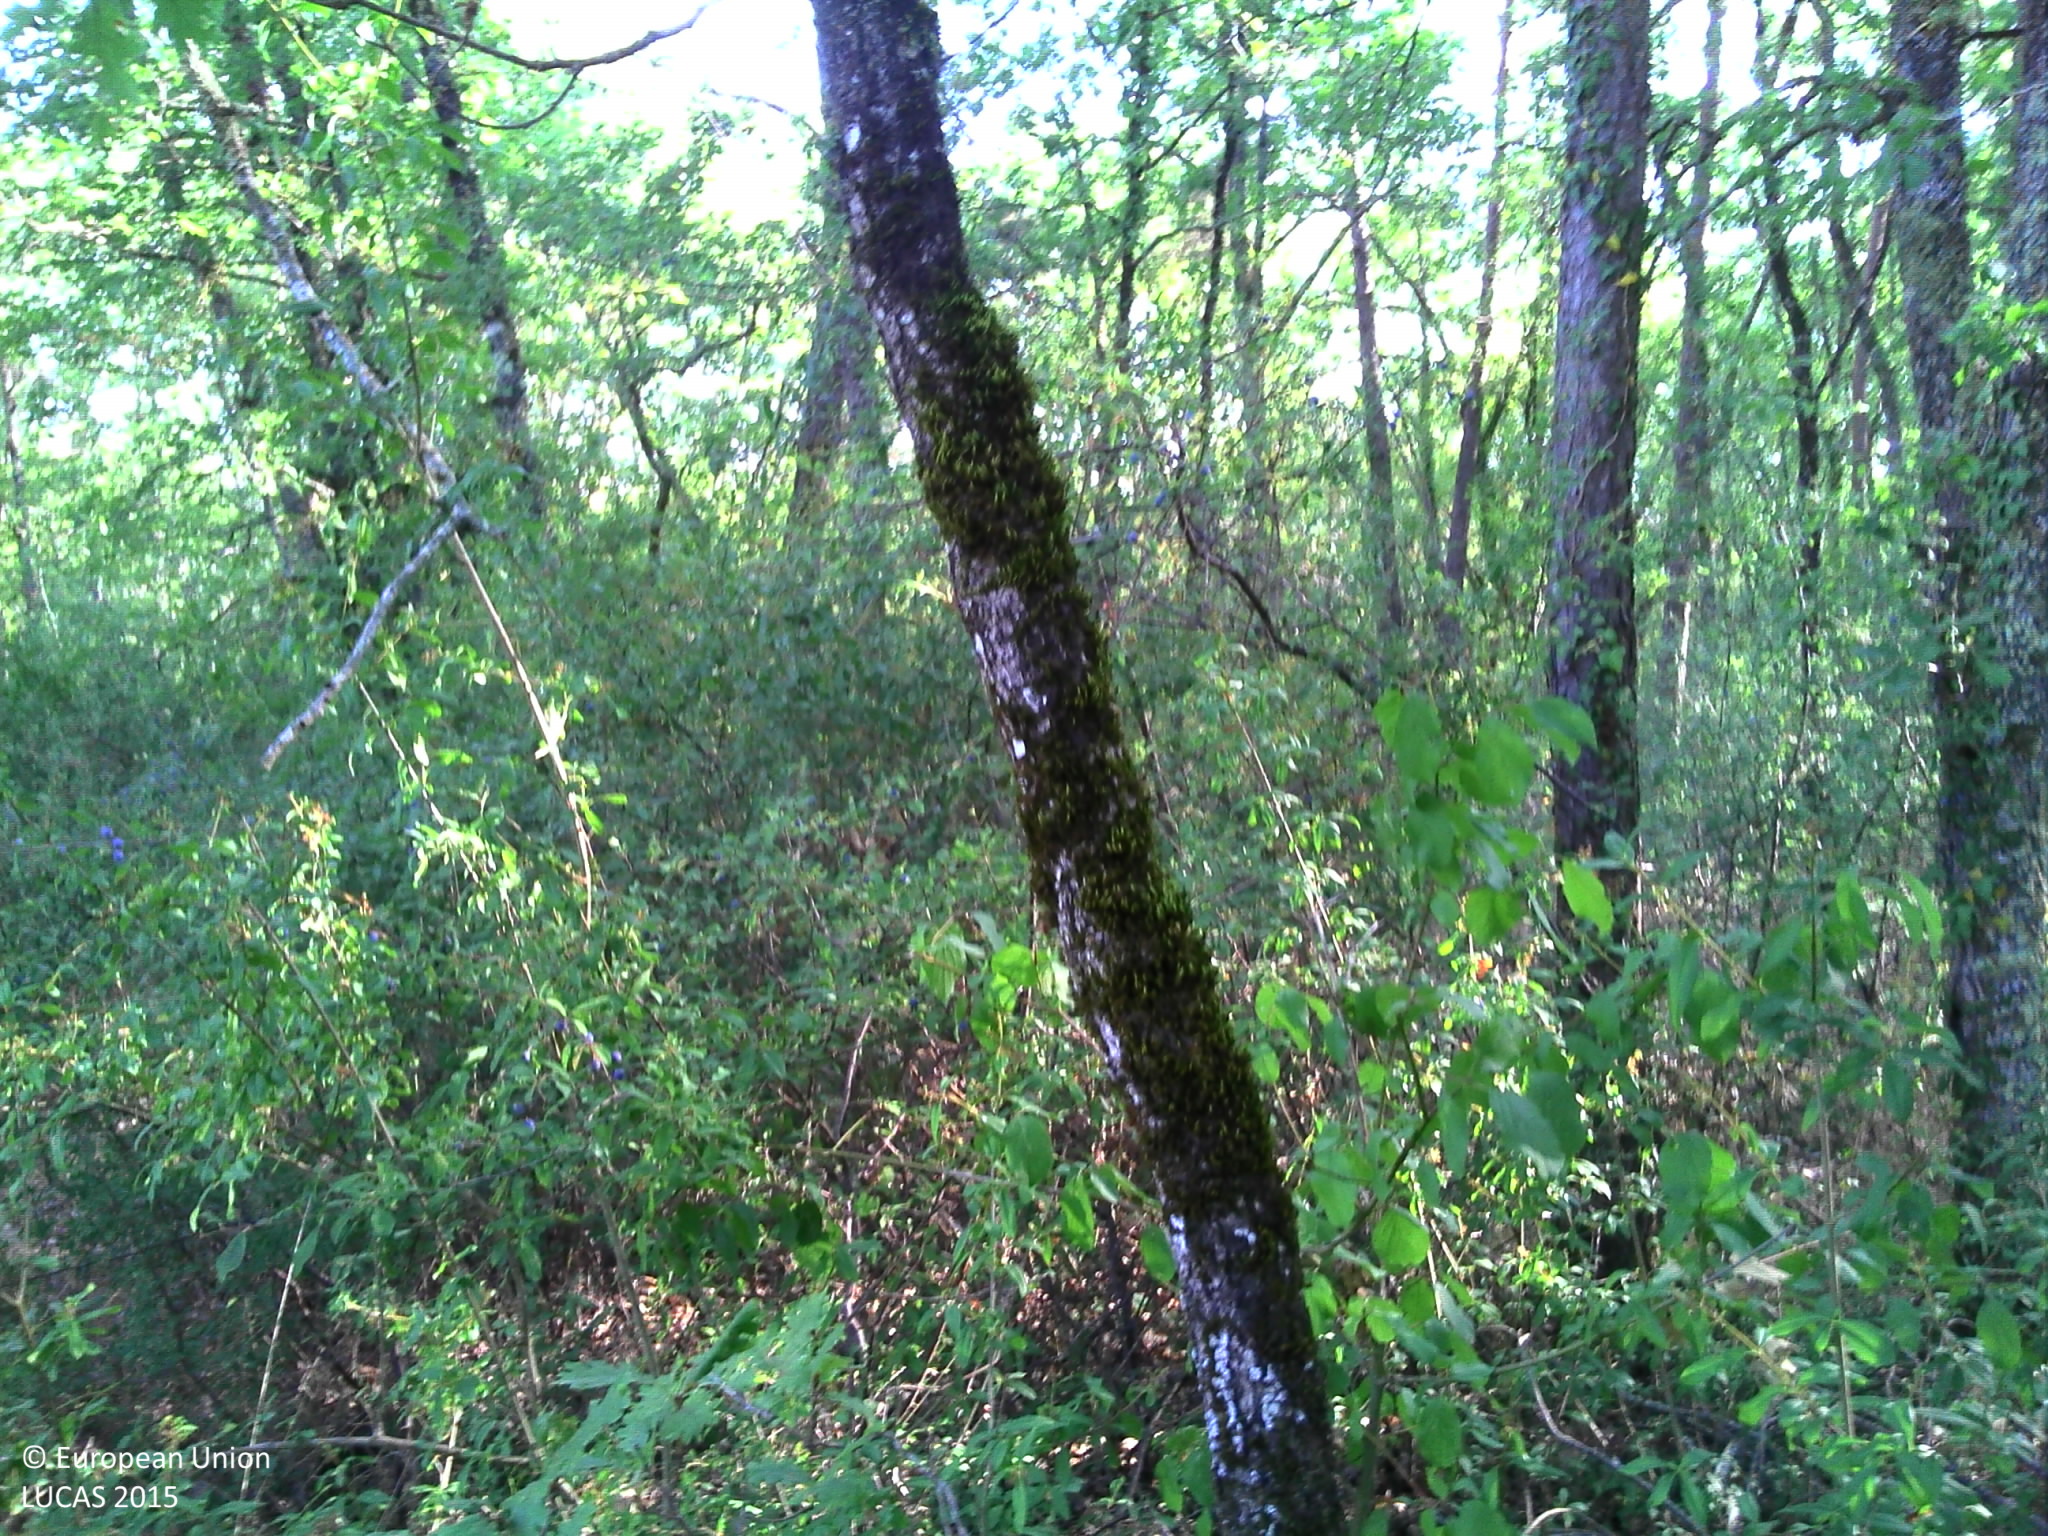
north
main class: Woodland
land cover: Broadleaved woodland
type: acidophilous oak and oak-birch forest
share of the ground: > 75 %
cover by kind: broadleaved forest trees 75 %, herbaceous plants 15 %, coniferous forest trees 5 %, shrubs 5 %
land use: Forestry
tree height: > 5 m
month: July
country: FR
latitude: 45.2514
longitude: 1.0602
